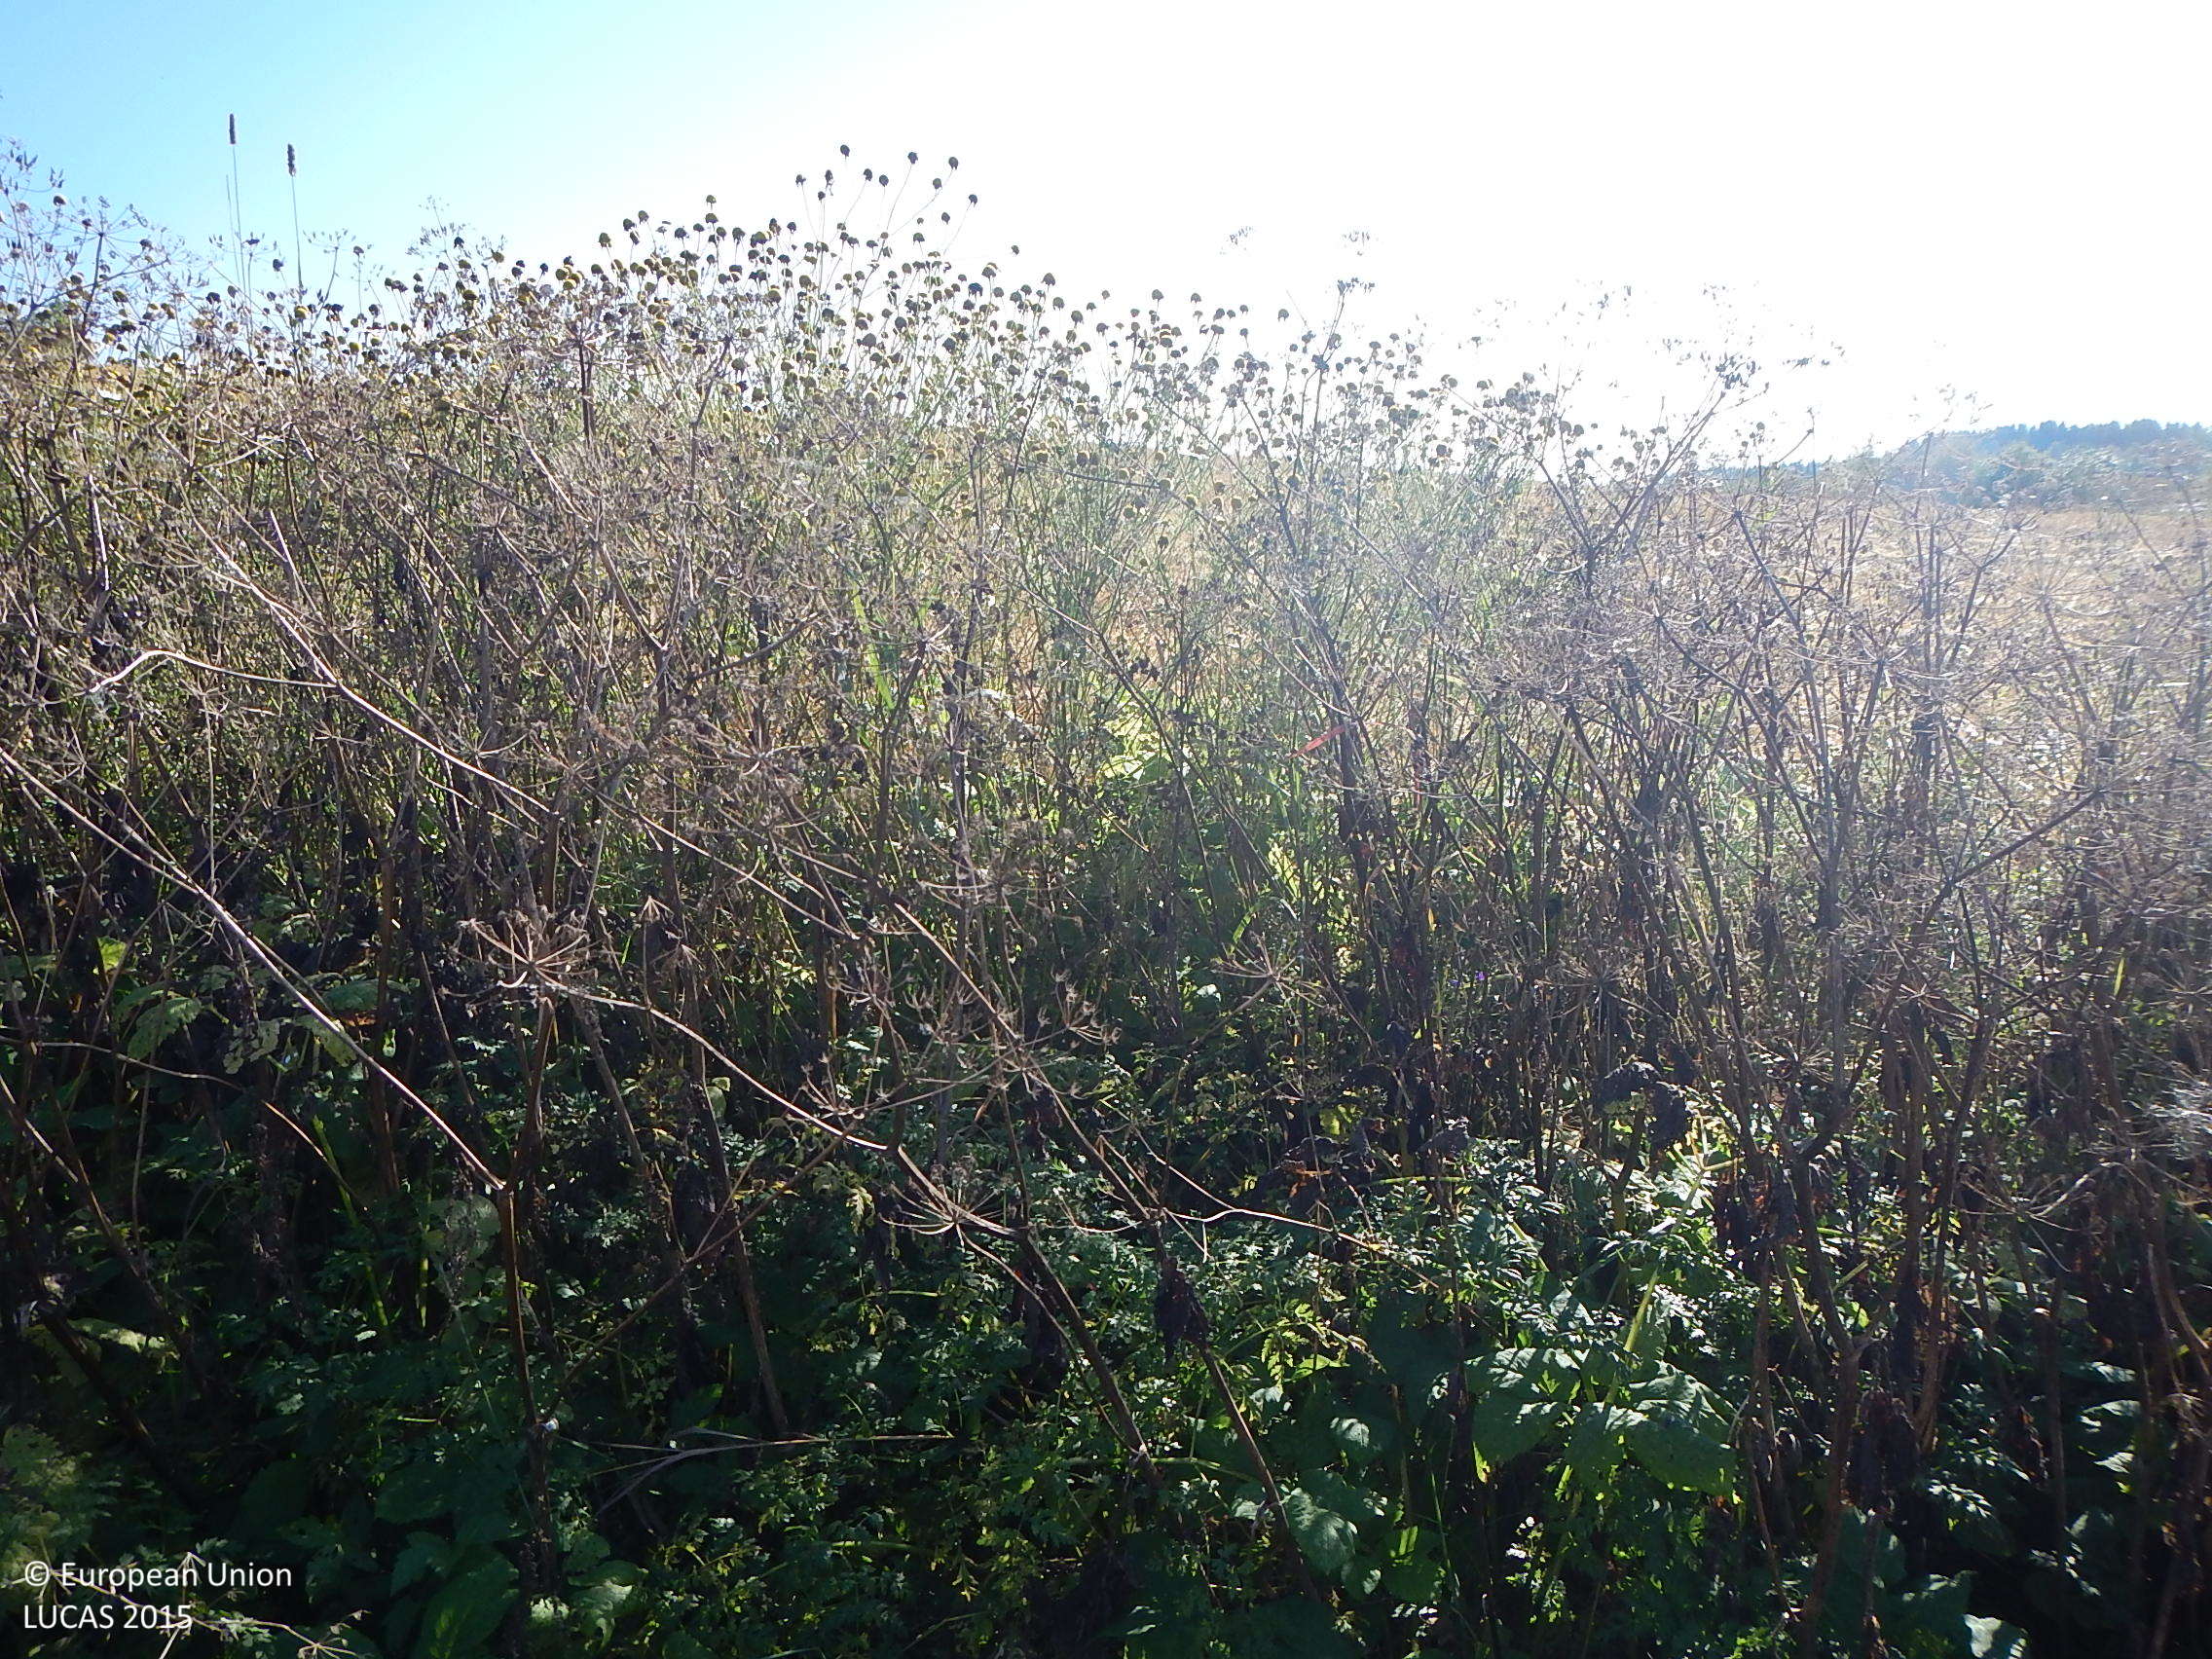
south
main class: Grassland
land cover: Spontaneously vegetated surfaces
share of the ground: > 75 %
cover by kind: herbaceous plants 100 %
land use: Semi-natural and natural areas not in use
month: September
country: FI
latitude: 61.6450
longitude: 22.7690
